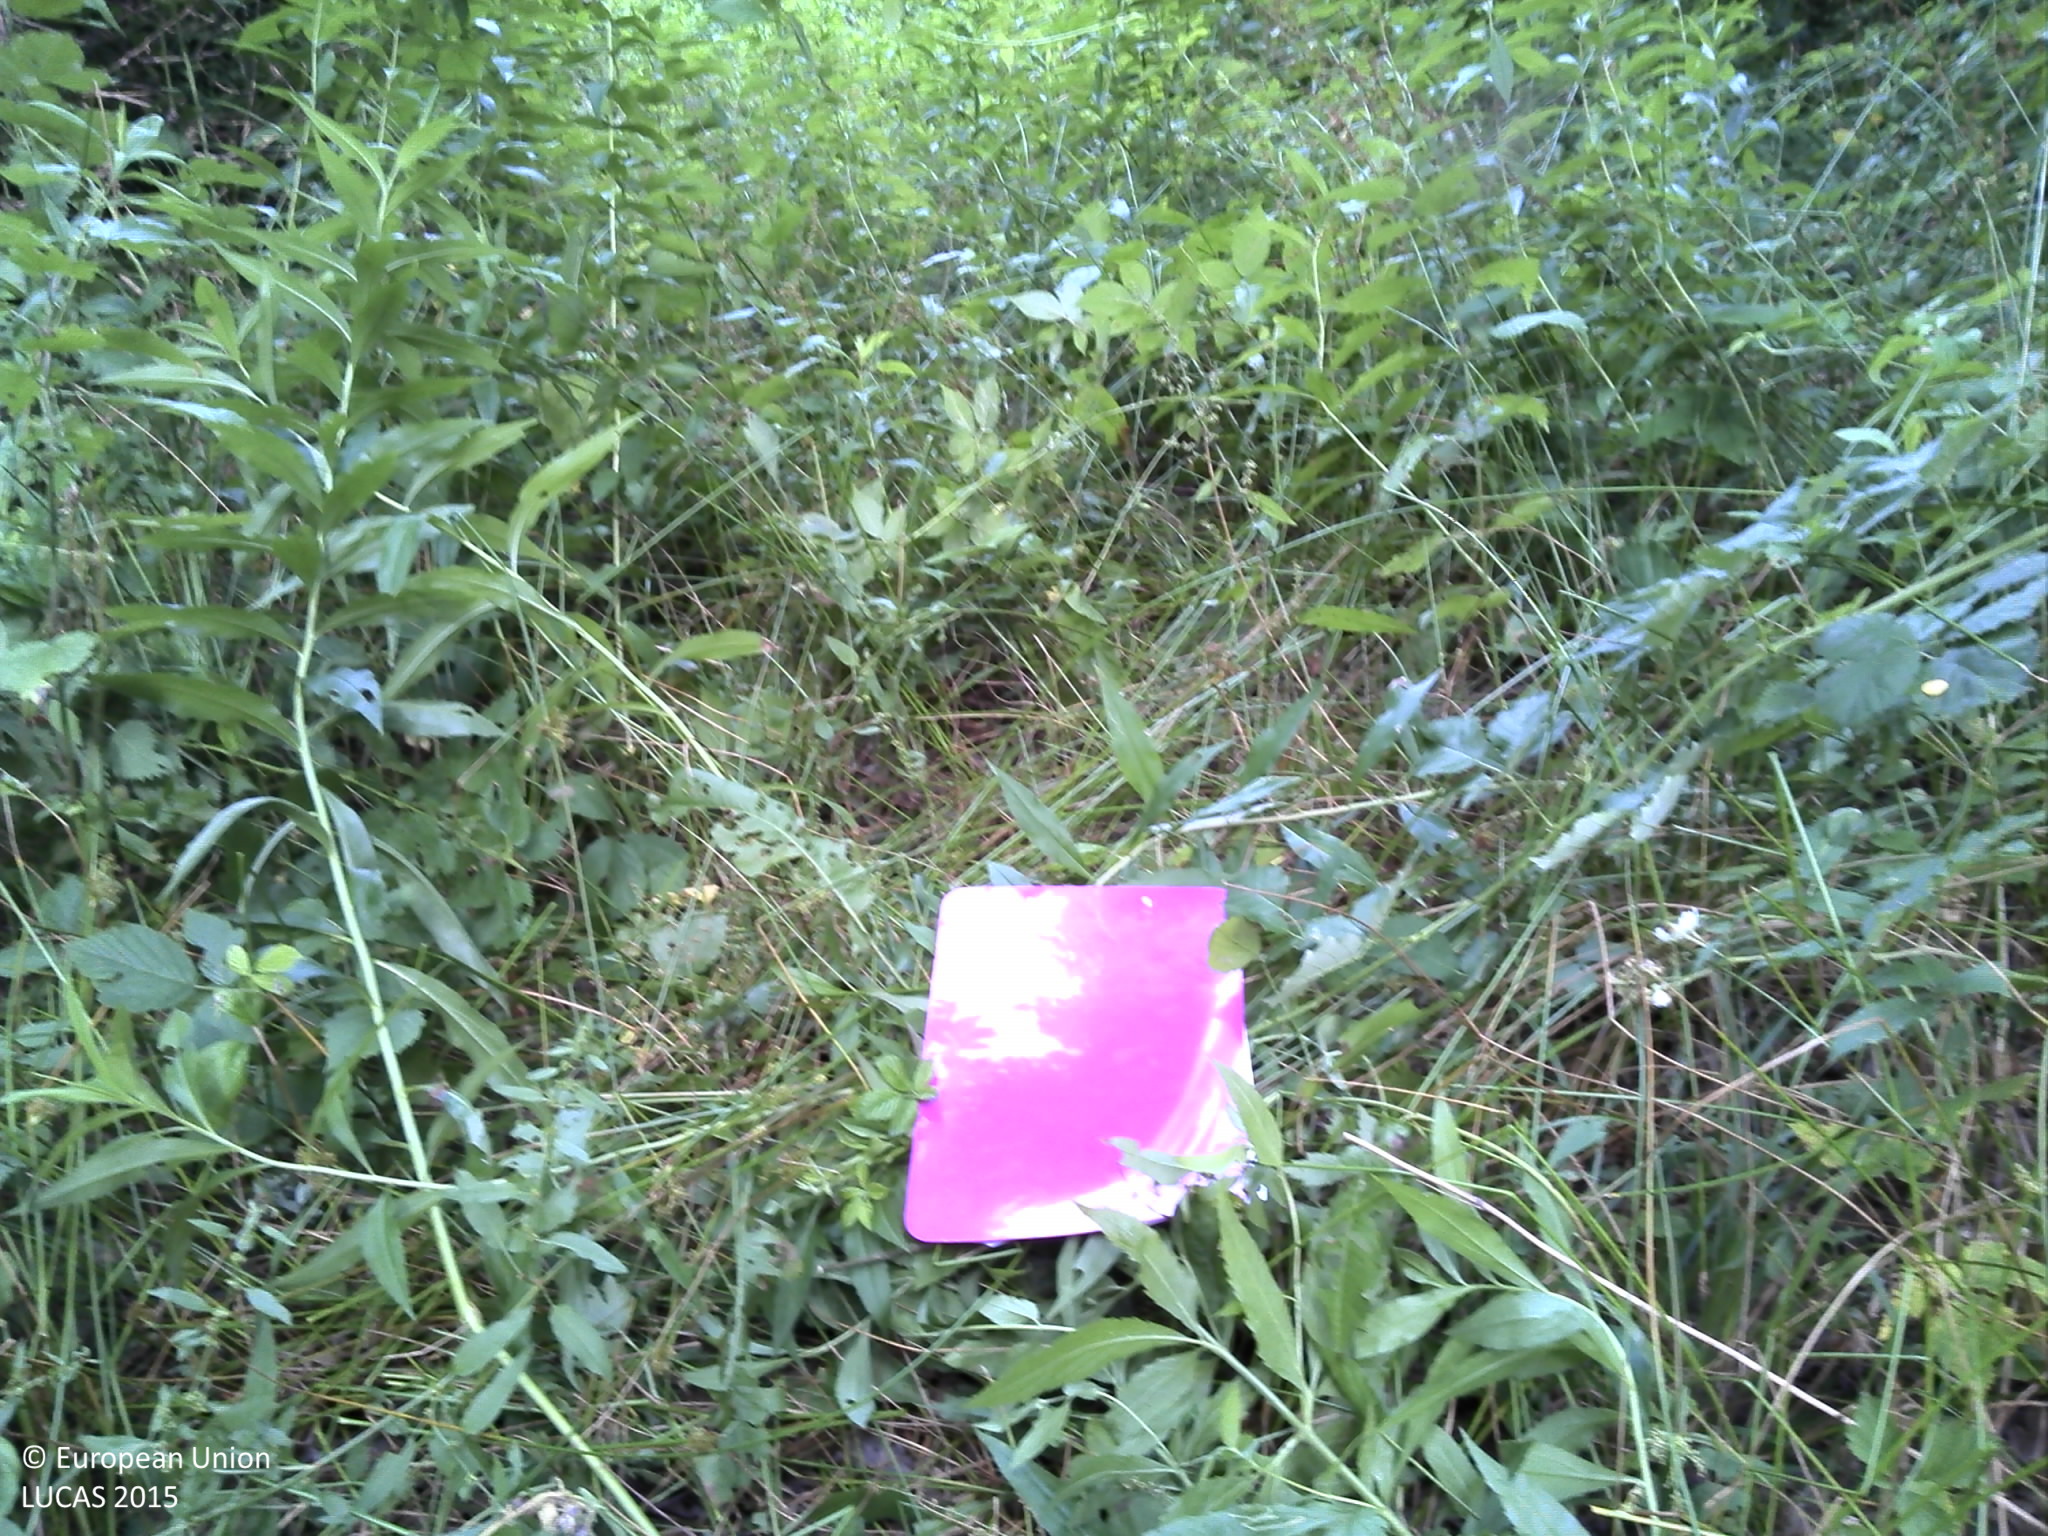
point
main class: Woodland
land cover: Broadleaved woodland
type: acidophilous oak and oak-birch forest
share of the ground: > 75 %
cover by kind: broadleaved forest trees 100 %
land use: Forestry
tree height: > 5 m
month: June
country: HR
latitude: 45.4186
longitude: 18.4528
